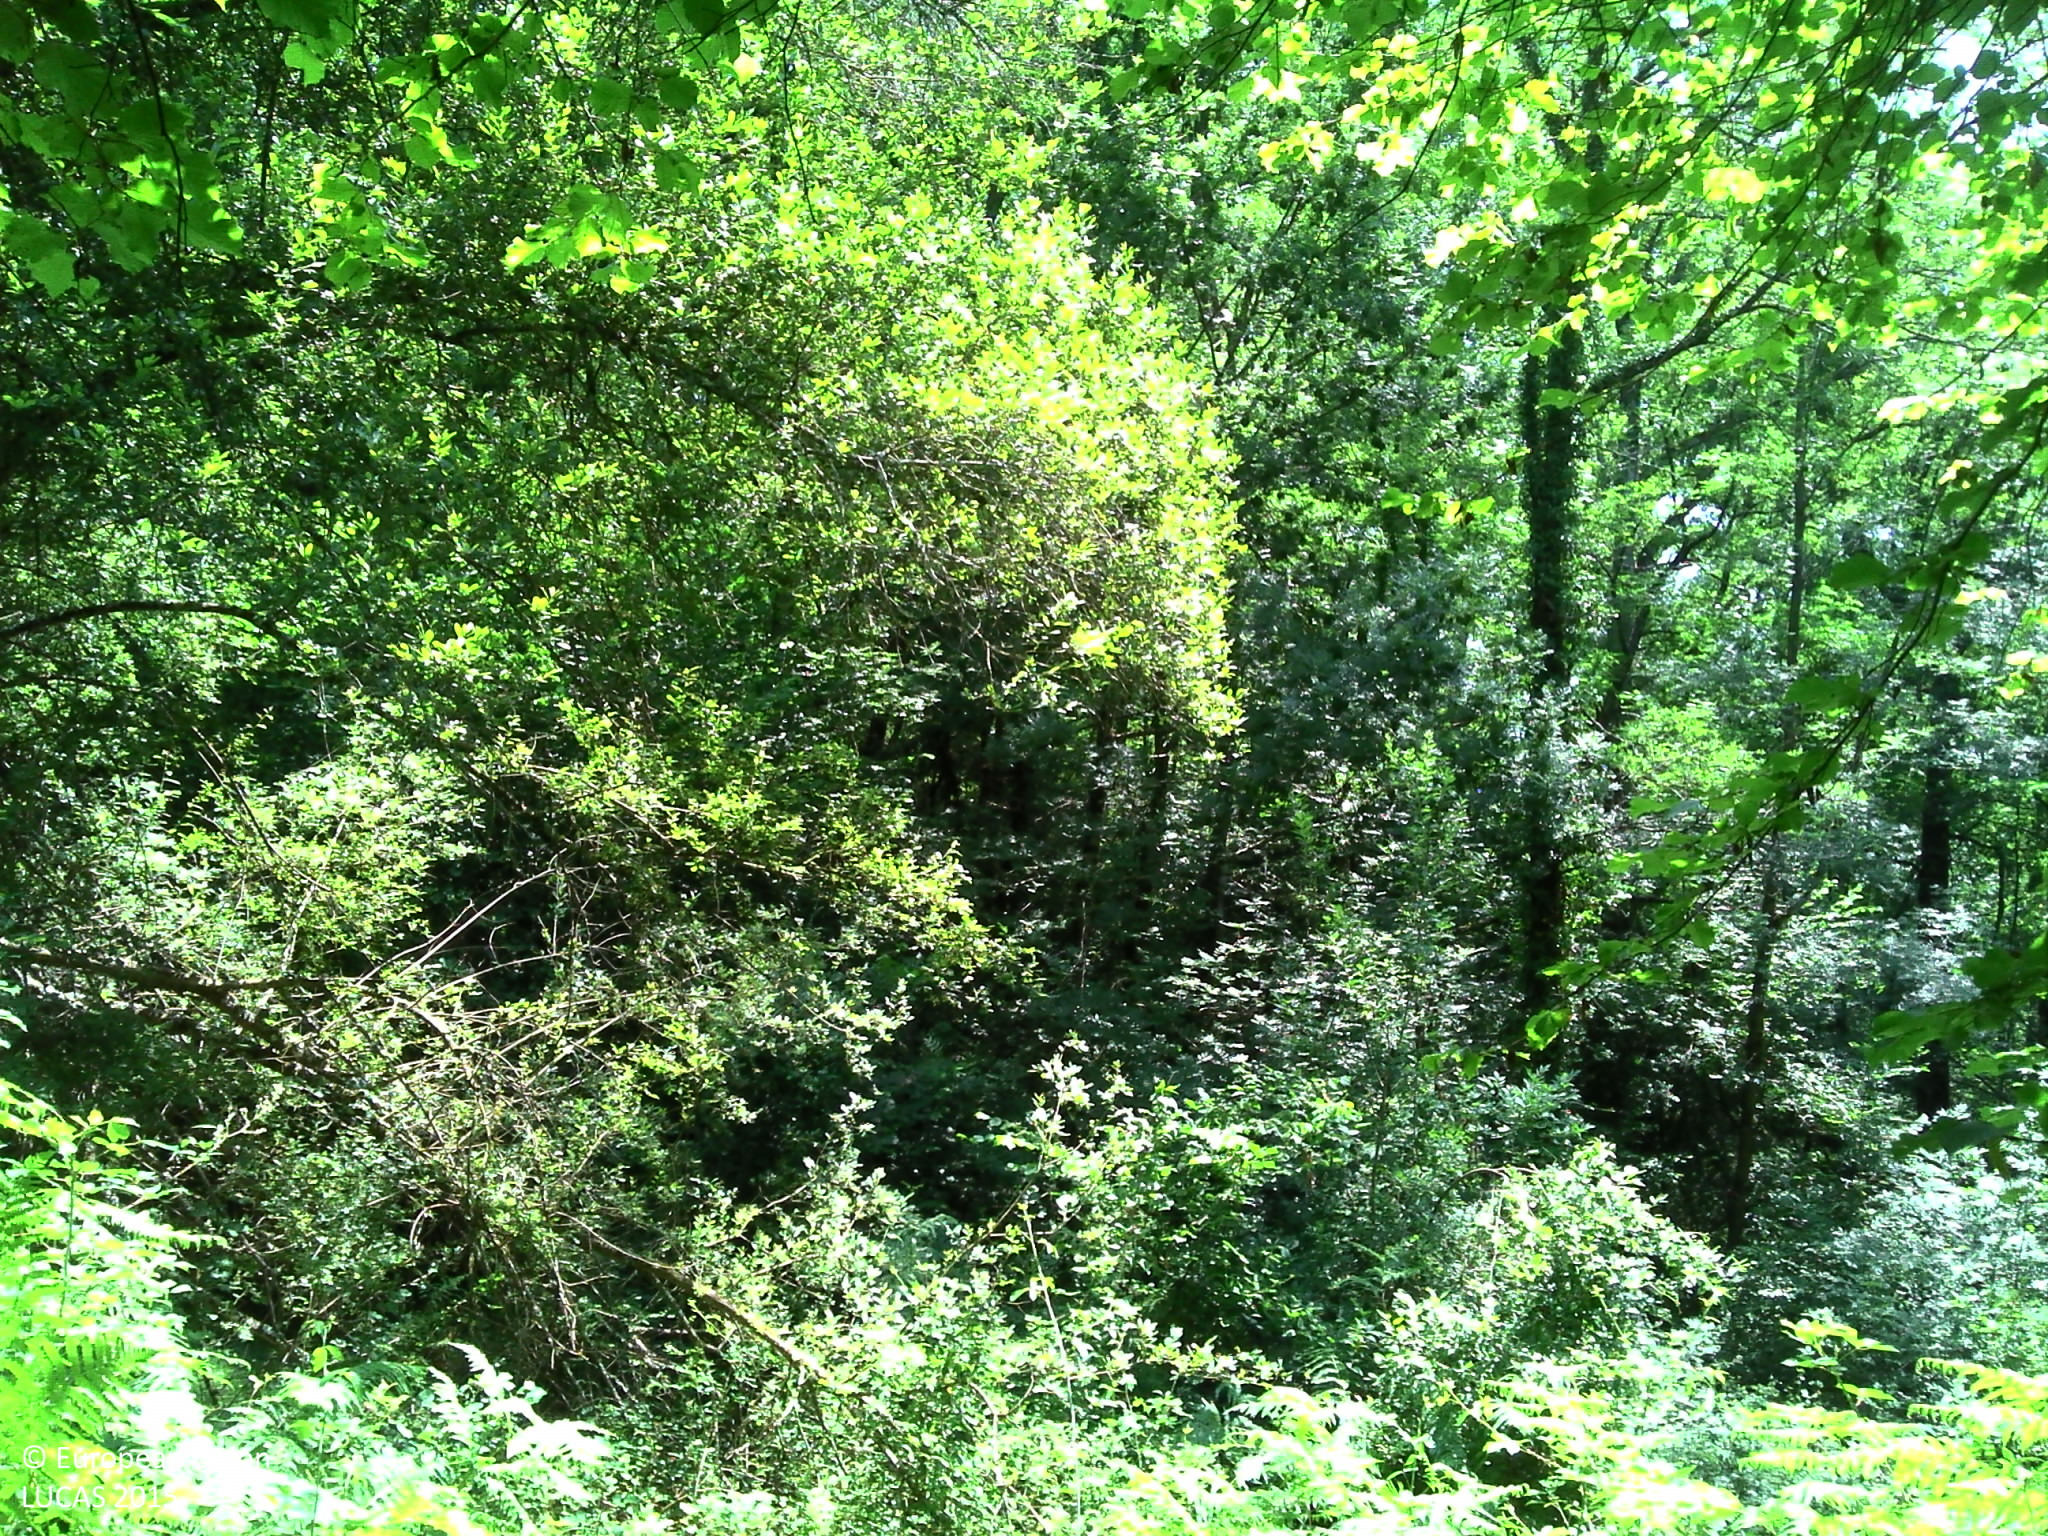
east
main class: Woodland
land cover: Broadleaved woodland
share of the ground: > 75 %
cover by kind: broadleaved forest trees 50 %, shrubs 40 %, herbaceous plants 10 %
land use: Agriculture (excluding fallow land and kitchen gardens)
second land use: Forestry
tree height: > 5 m
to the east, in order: Broadleaved woodland; Grassland without tree/shrub cover; Rivers and streams; Broadleaved woodland
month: July
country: FR
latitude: 43.0541
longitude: 1.0289
